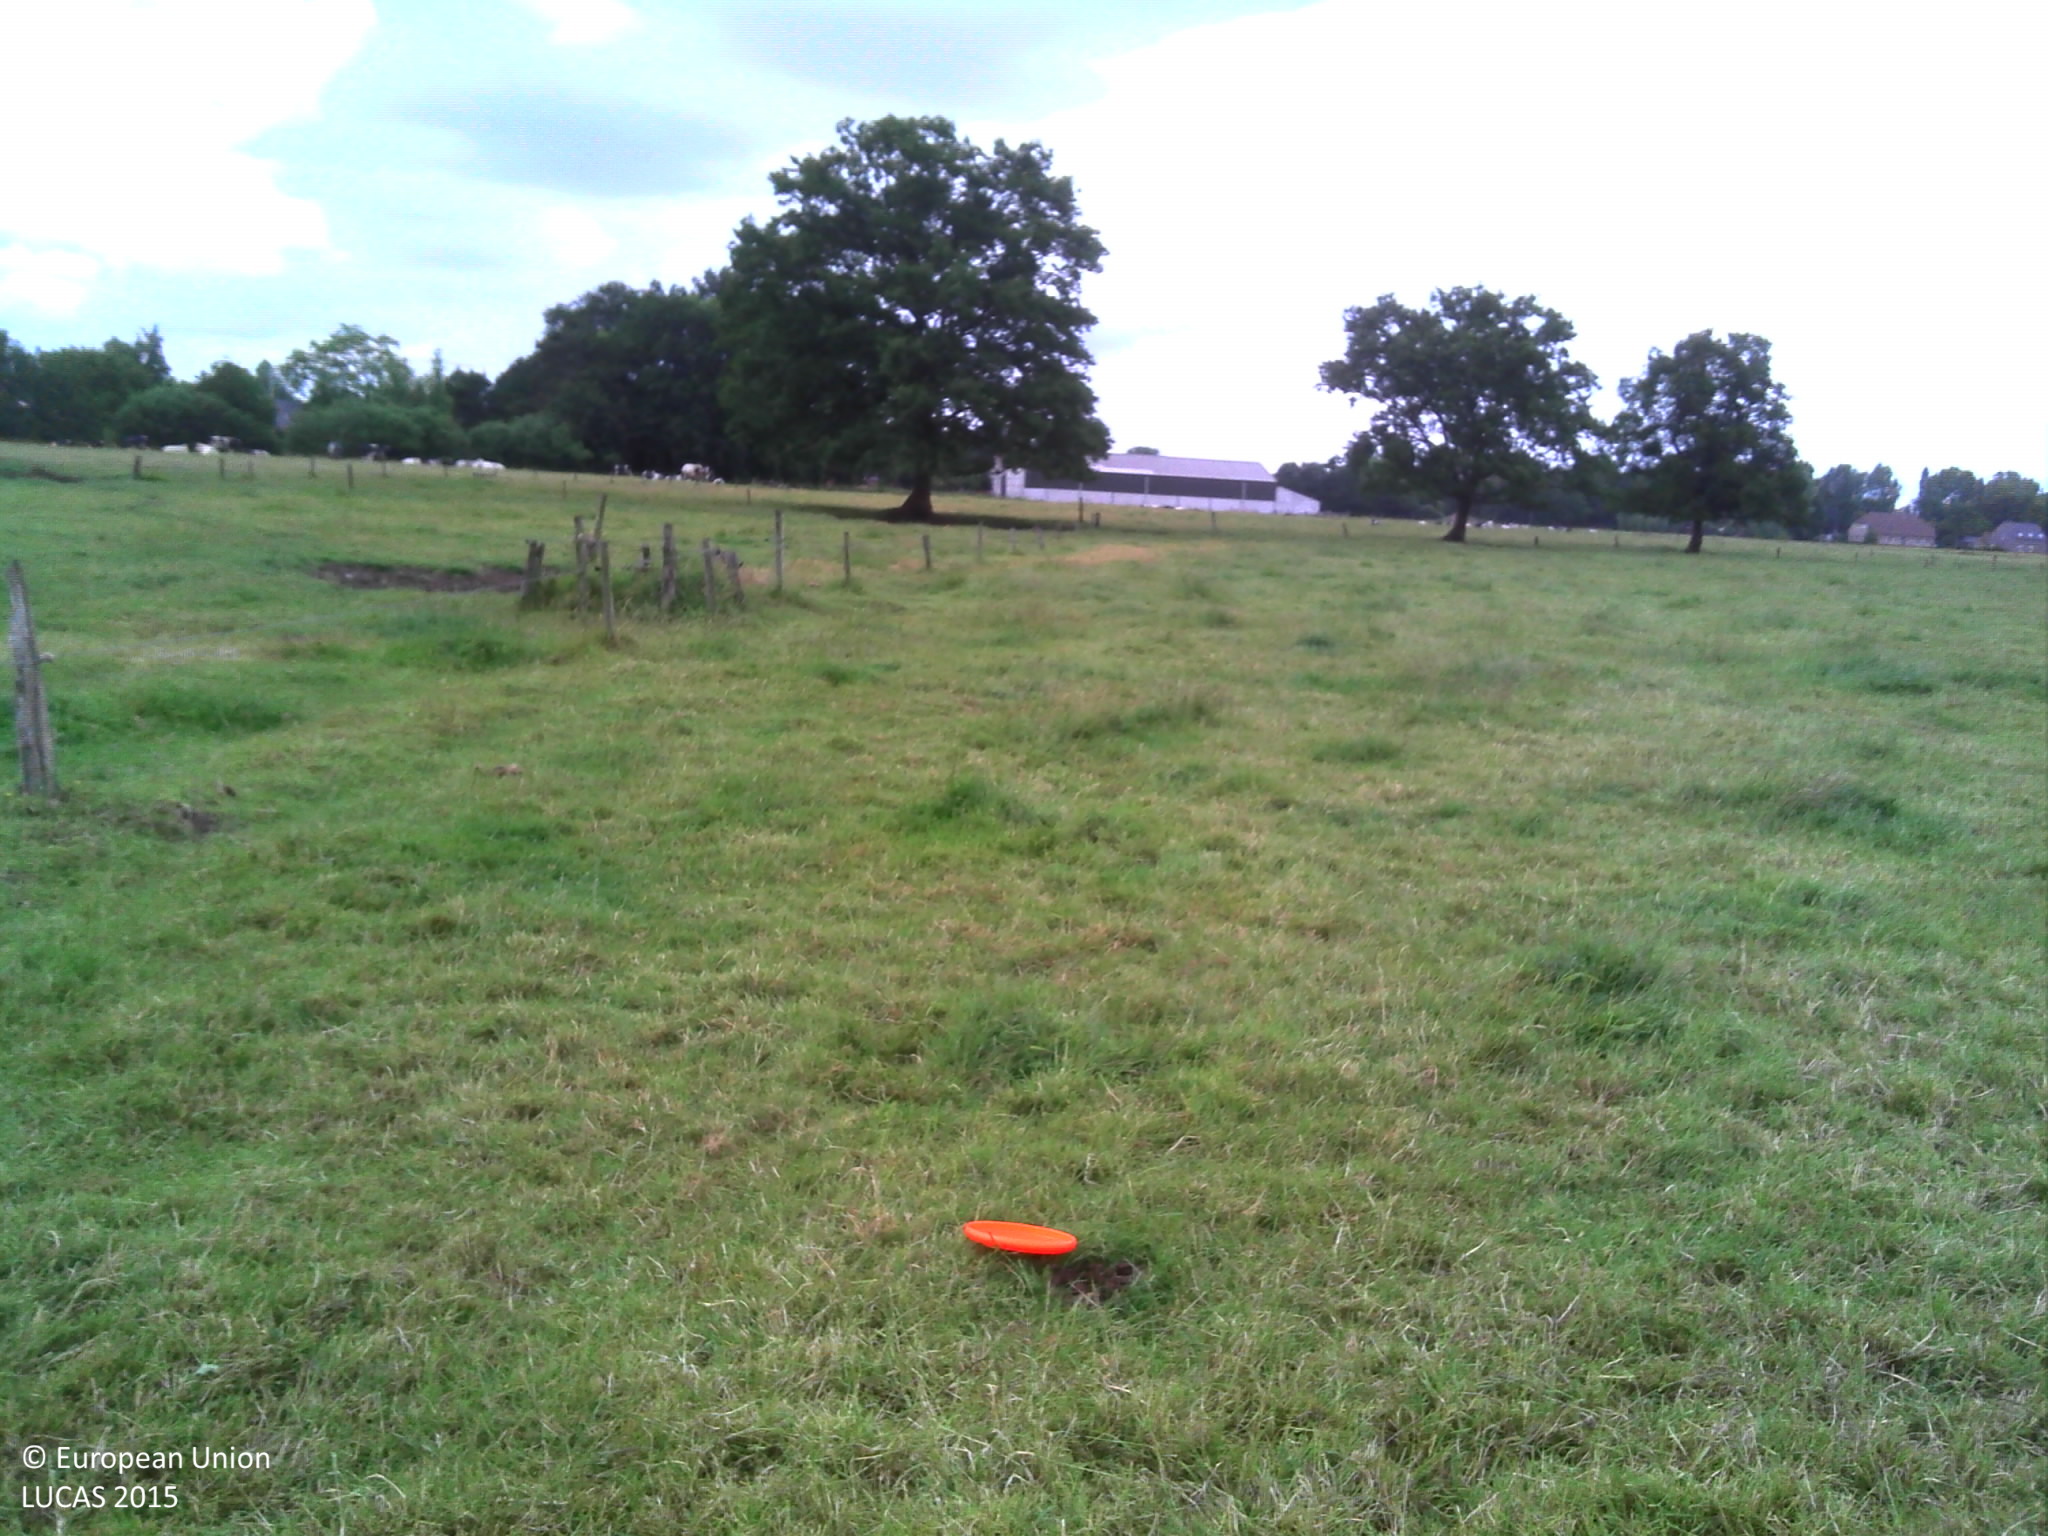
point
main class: Grassland
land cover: Grassland without tree/shrub cover
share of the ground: > 75 %
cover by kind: herbaceous plants 100 %
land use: Agriculture (excluding fallow land and kitchen gardens)
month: June
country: BE
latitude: 51.1951
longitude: 3.9408
